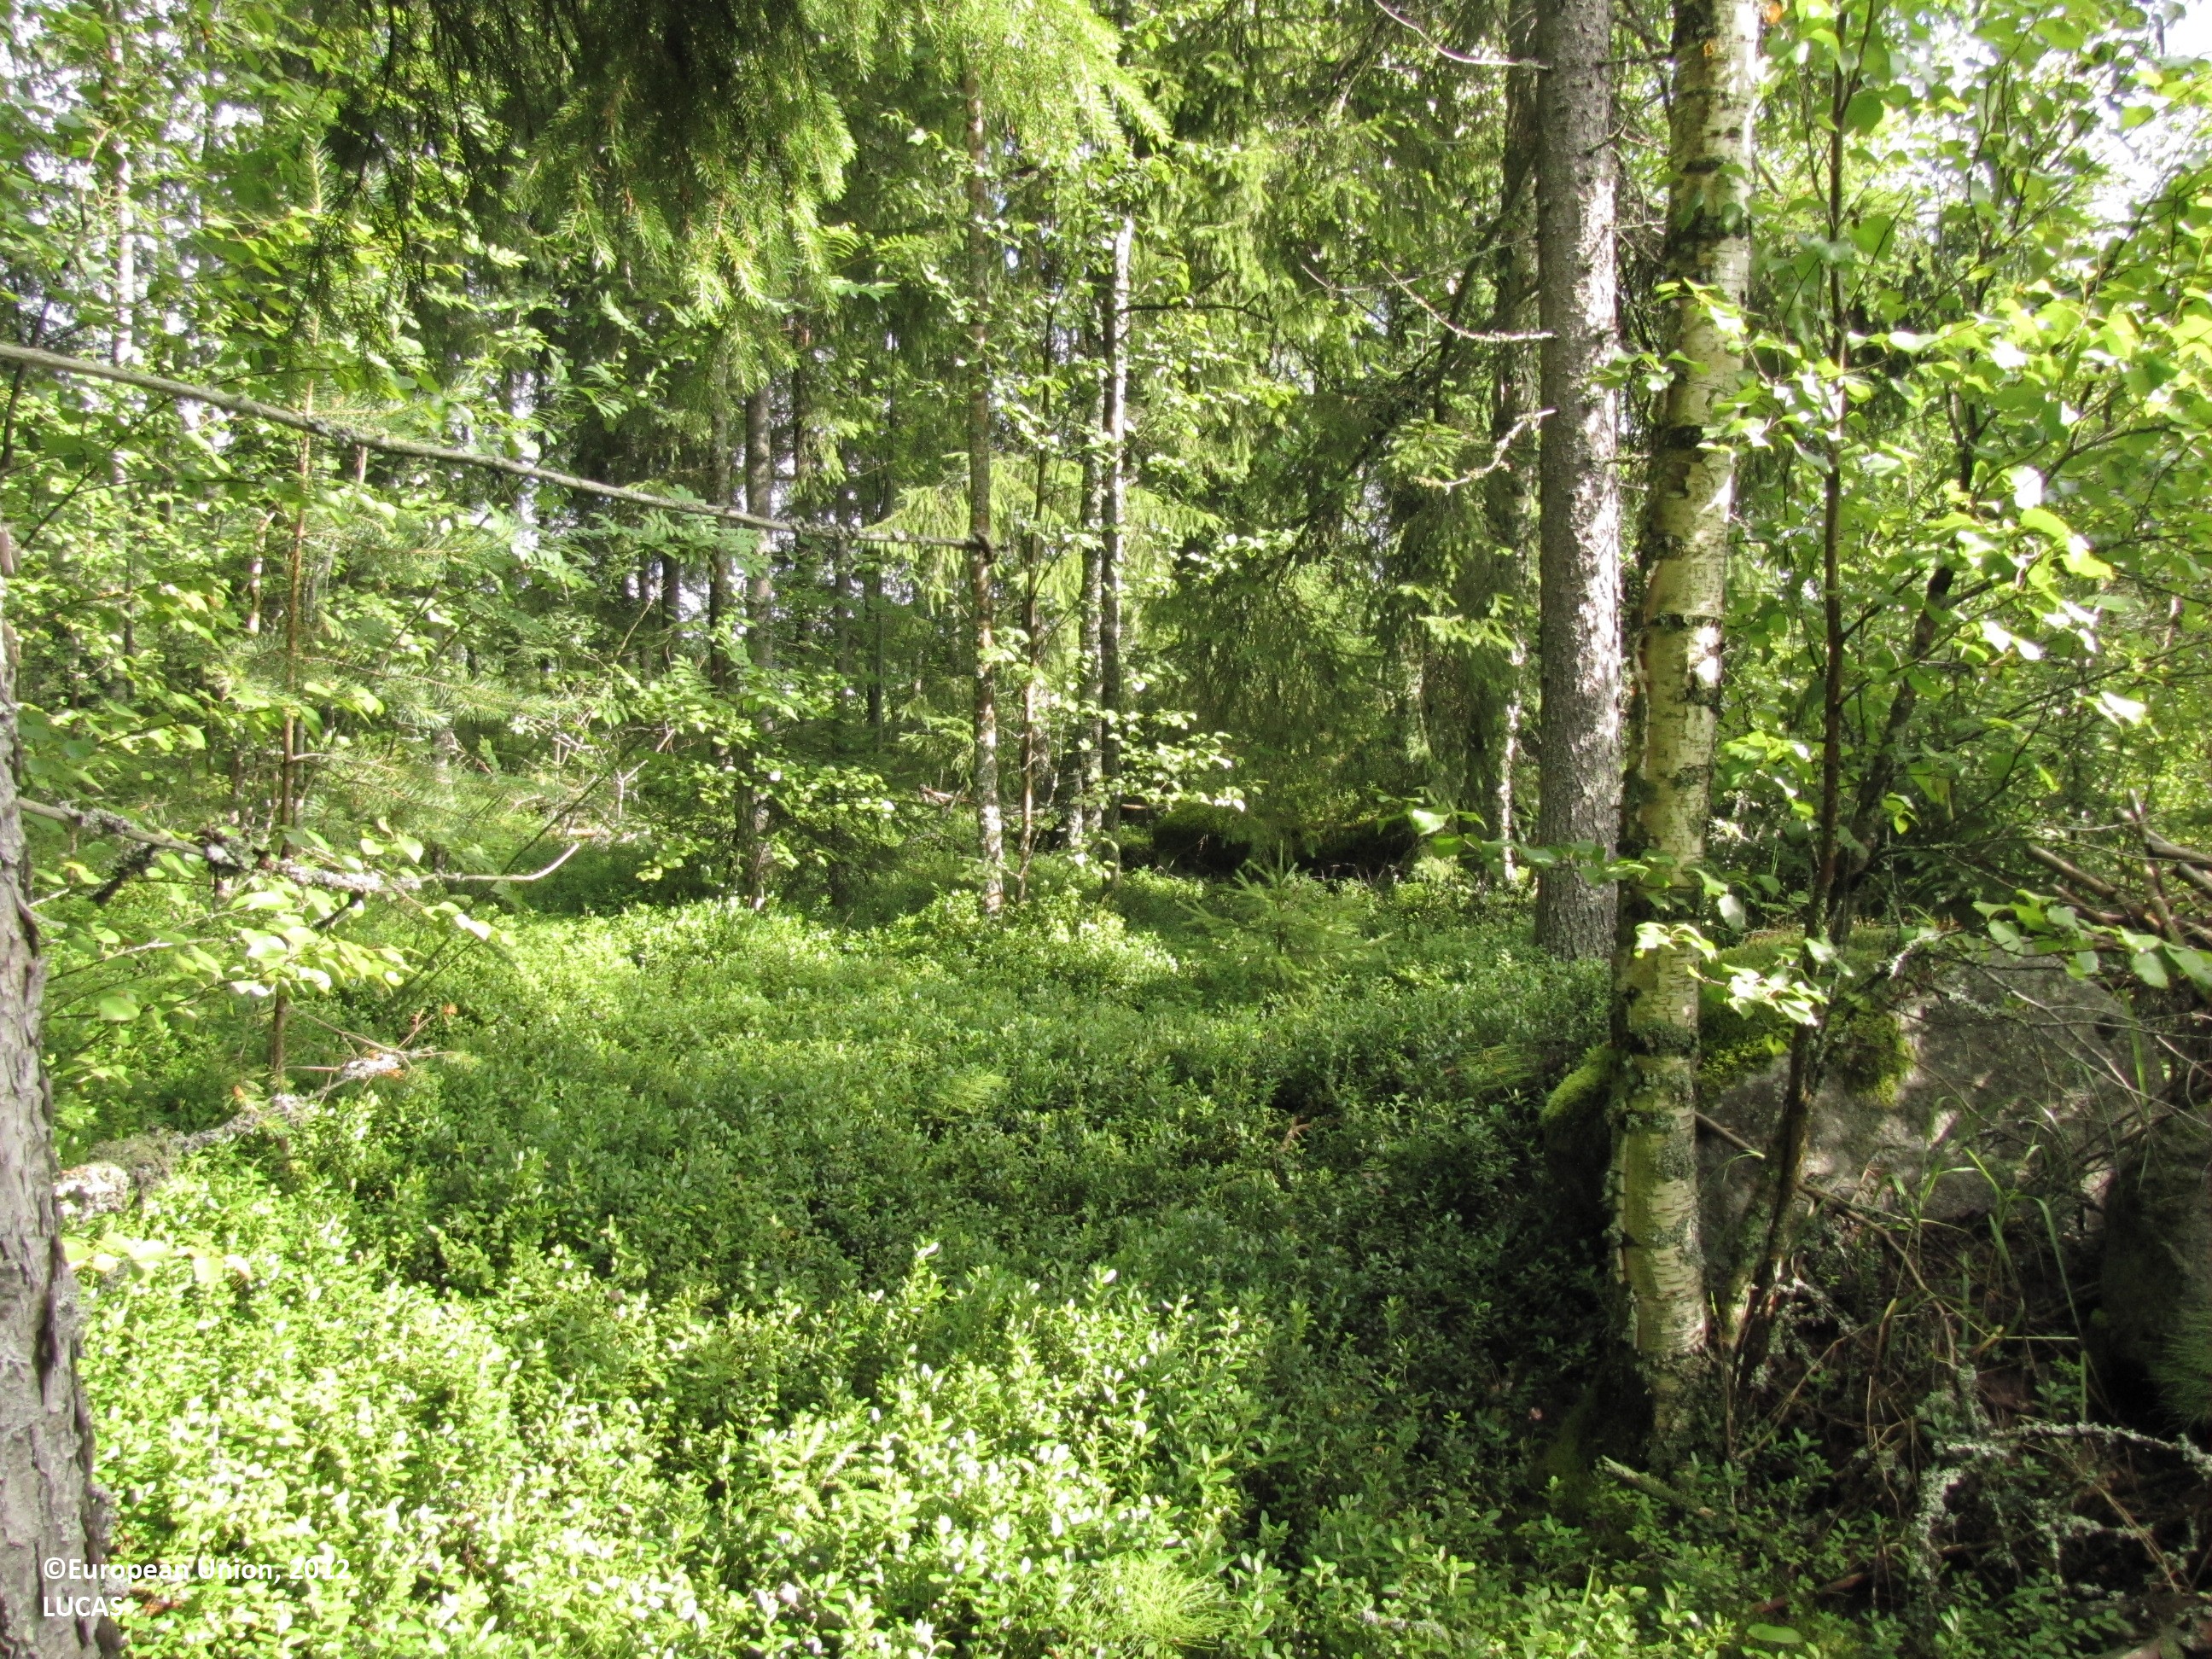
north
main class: Woodland
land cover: Pine dominated mixed woodland
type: boreal forest
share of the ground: 25 - 50 %
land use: Forestry
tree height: > 5 m
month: July
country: FI
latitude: 62.2036
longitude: 23.0801
